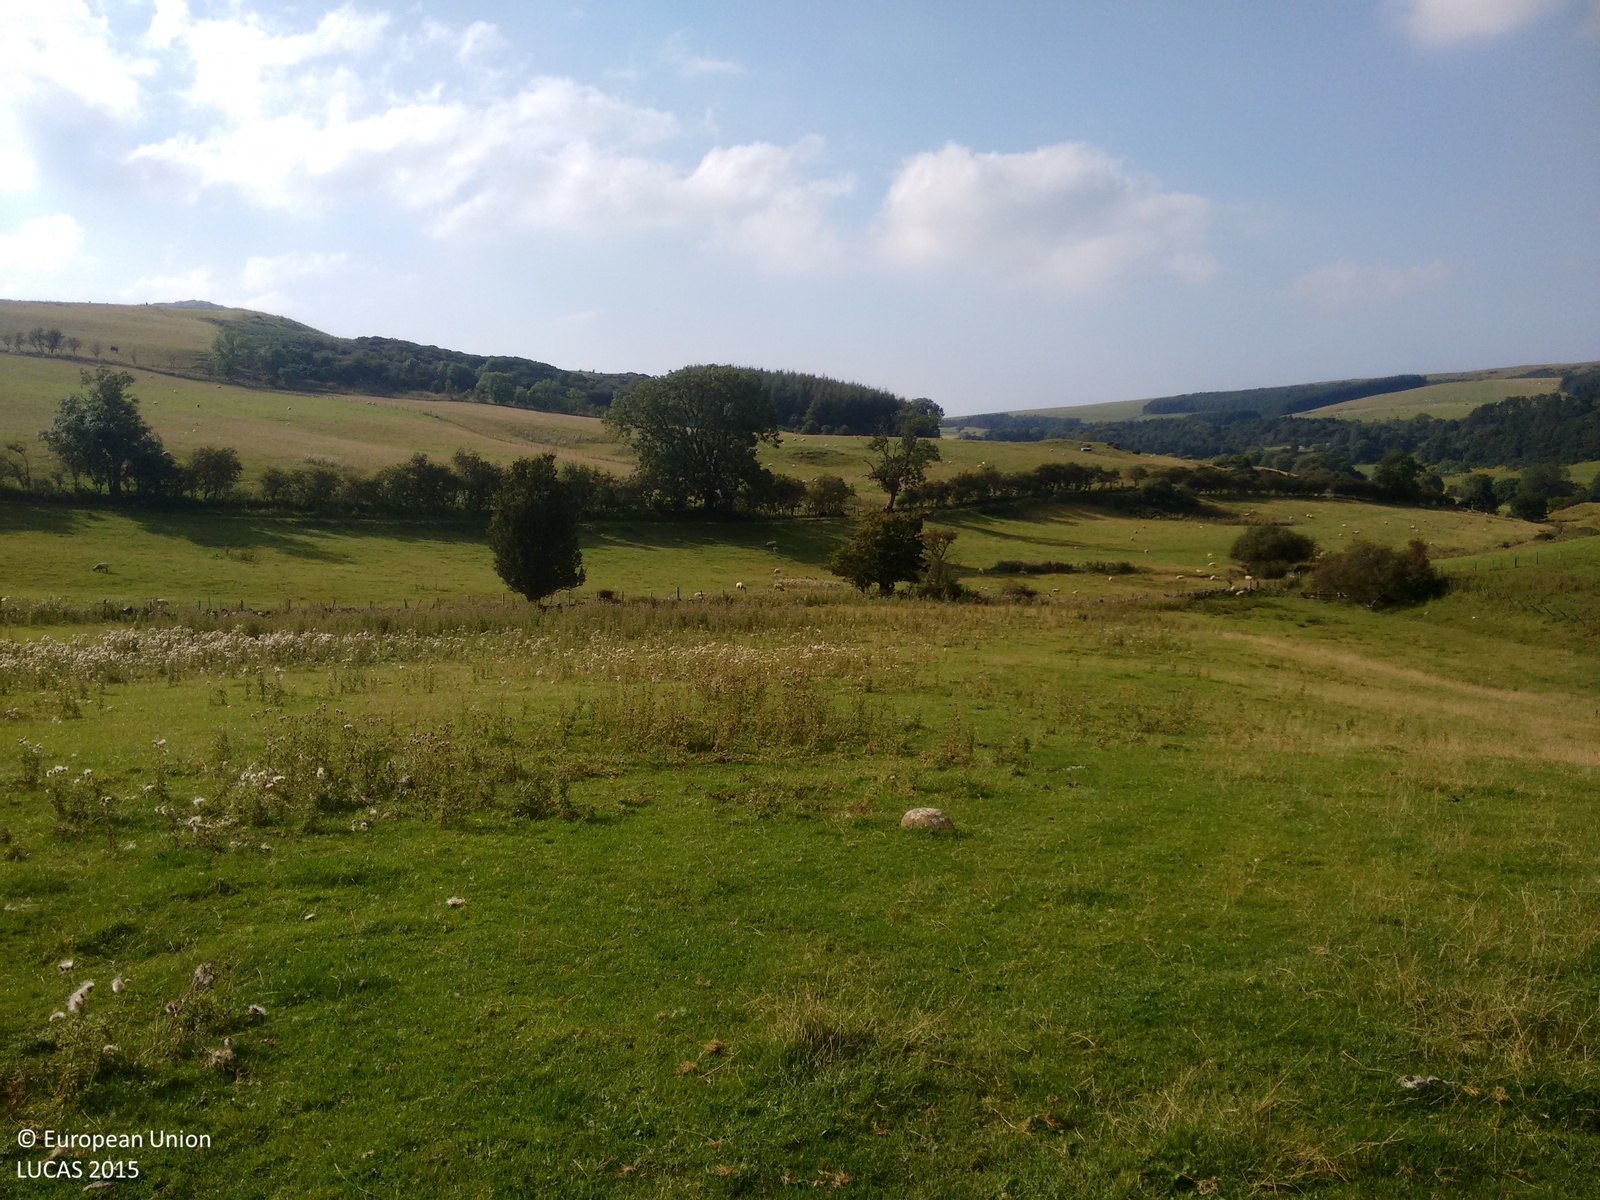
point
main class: Grassland
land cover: Grassland without tree/shrub cover
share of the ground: > 75 %
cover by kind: herbaceous plants 100 %
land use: Agriculture (excluding fallow land and kitchen gardens)
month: September
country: GB
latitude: 55.1239
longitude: -4.9303
